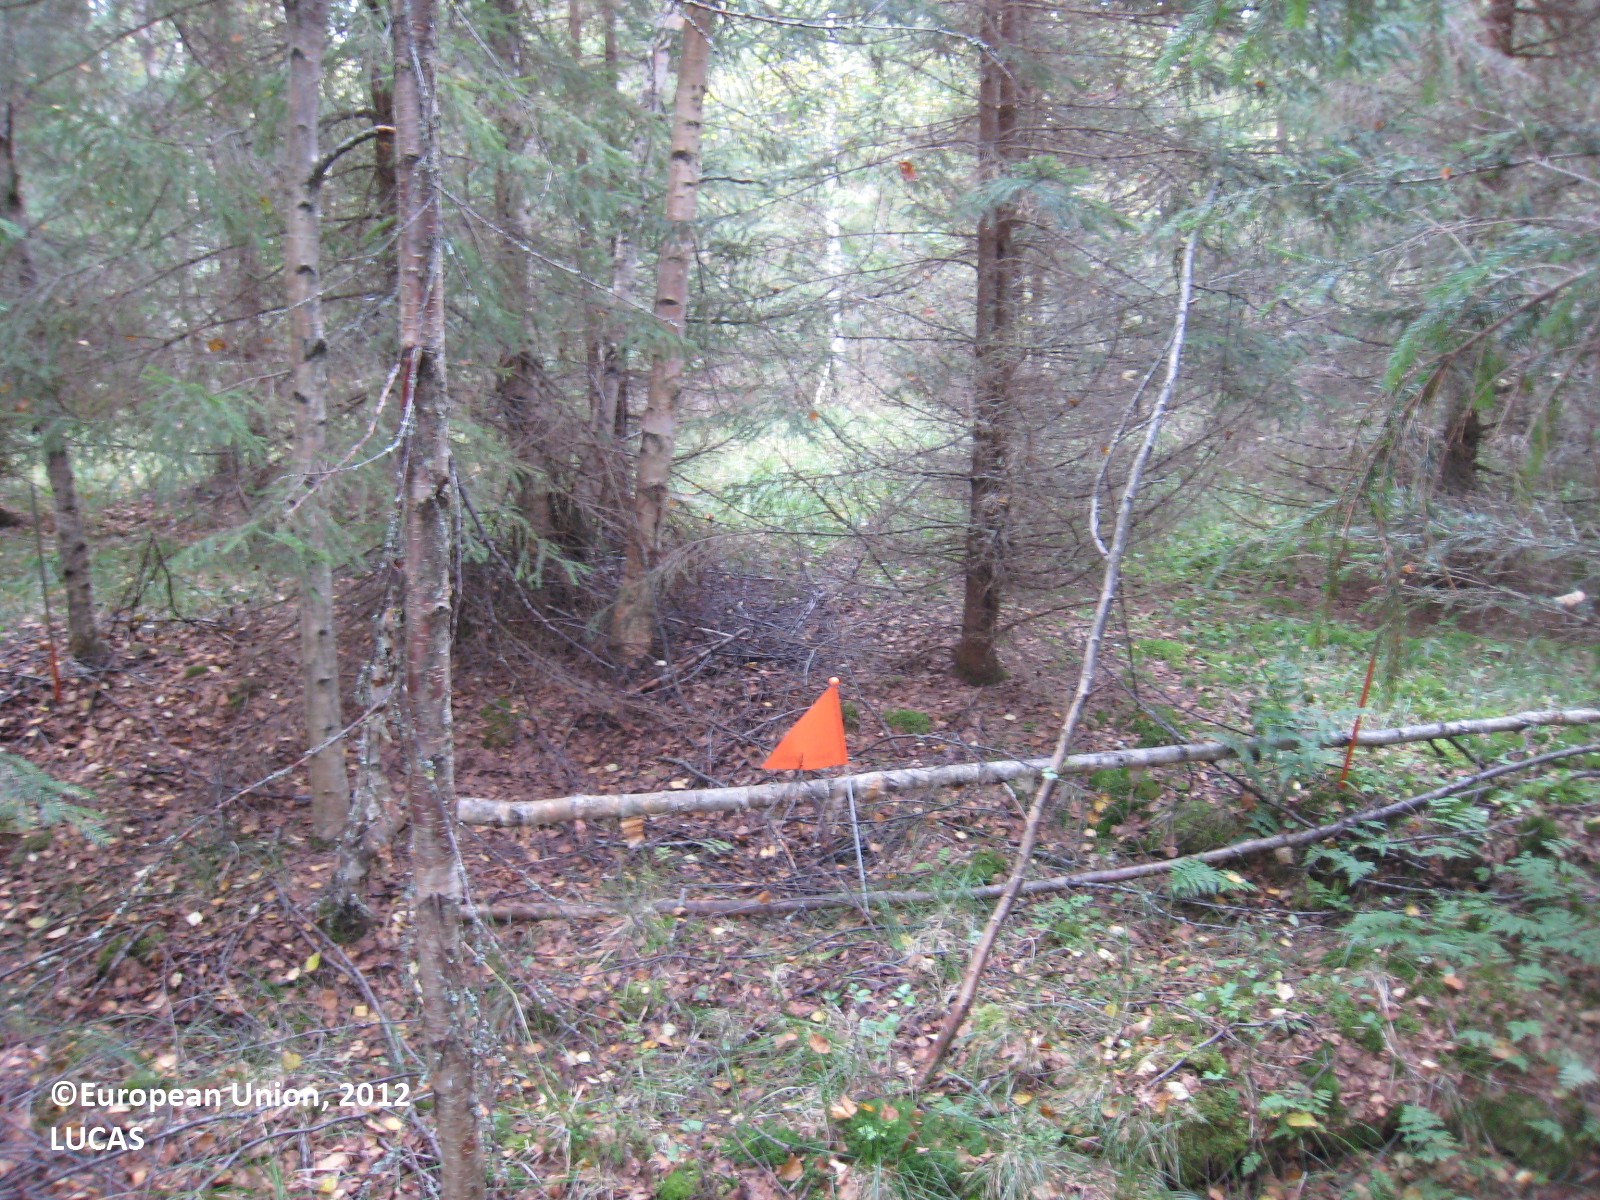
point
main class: Woodland
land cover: Spruce dominated mixed woodland
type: boreal forest
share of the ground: > 75 %
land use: Forestry
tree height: > 5 m
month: August
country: FI
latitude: 62.2936
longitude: 27.3824
